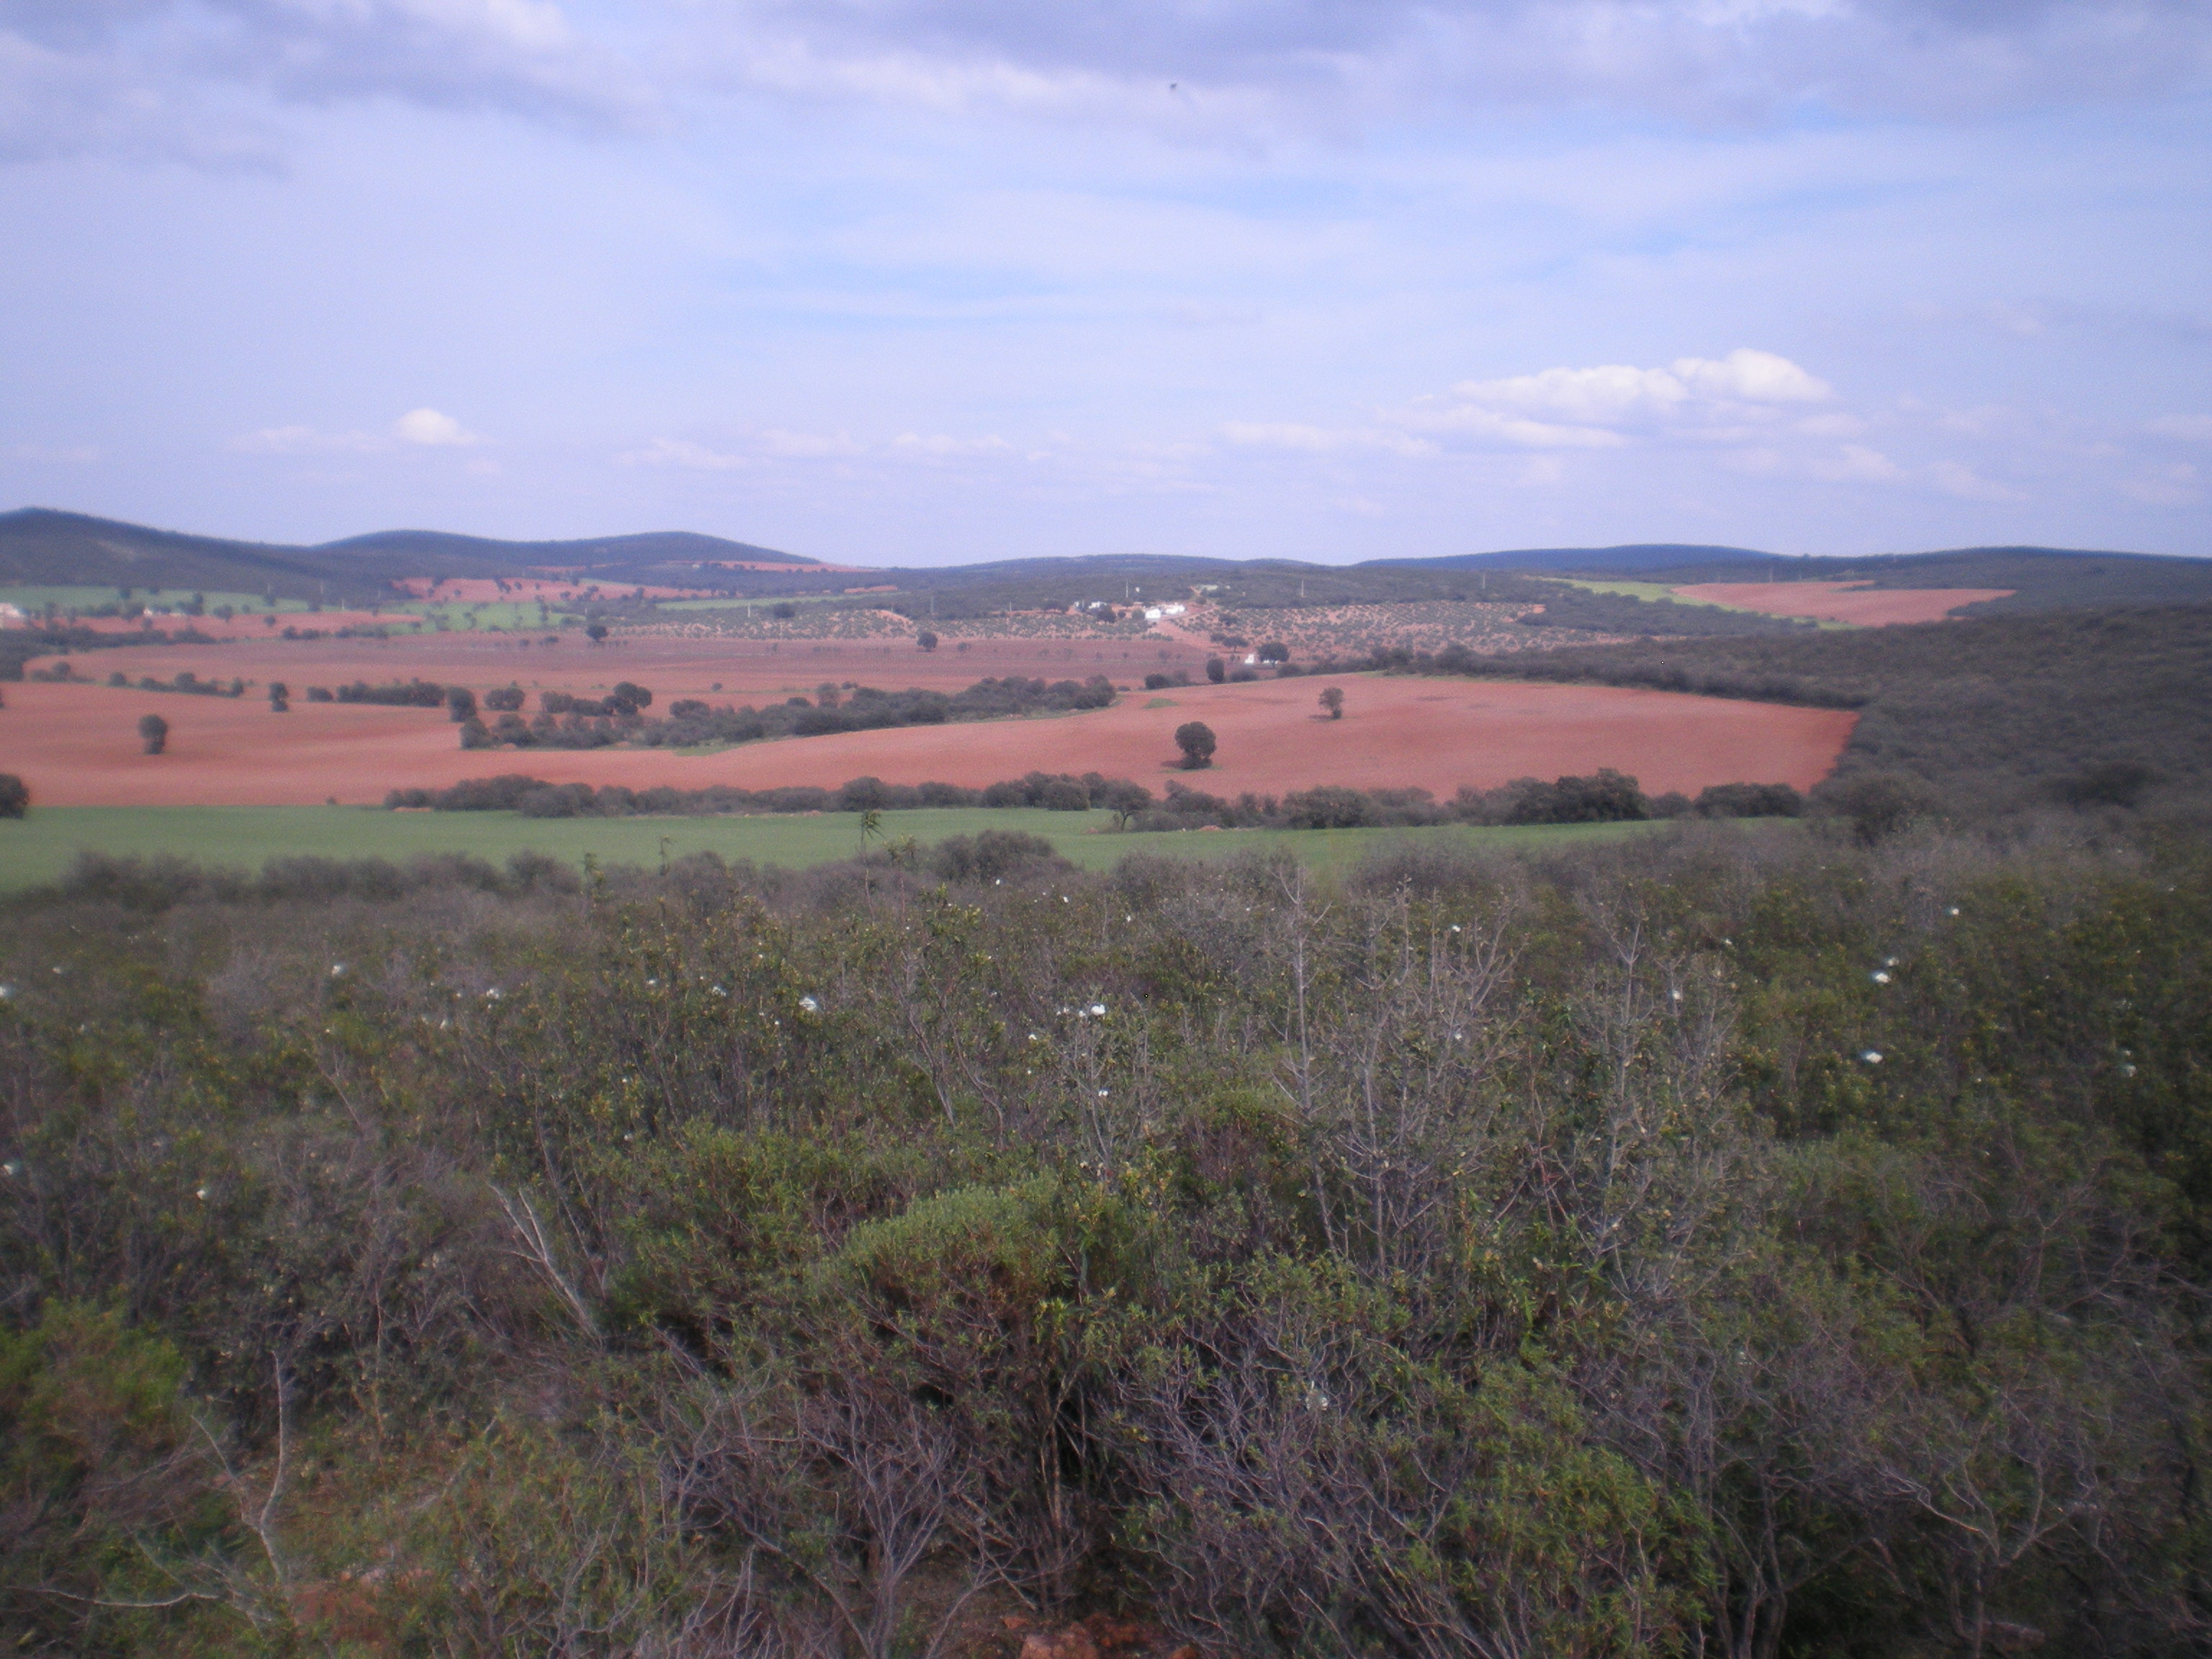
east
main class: Shrubland
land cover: Shrubland with sparse tree cover
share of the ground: > 75 %
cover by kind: shrubs 80 %, herbaceous plants 10 %, broadleaved forest trees 5 %, unconsolidated bare surface 5 %
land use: Other primary production
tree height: < 5 m
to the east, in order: Shrubland with sparse tree cover; Broadleaved woodland; Oats
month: April
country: ES
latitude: 38.8846
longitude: -3.5367
